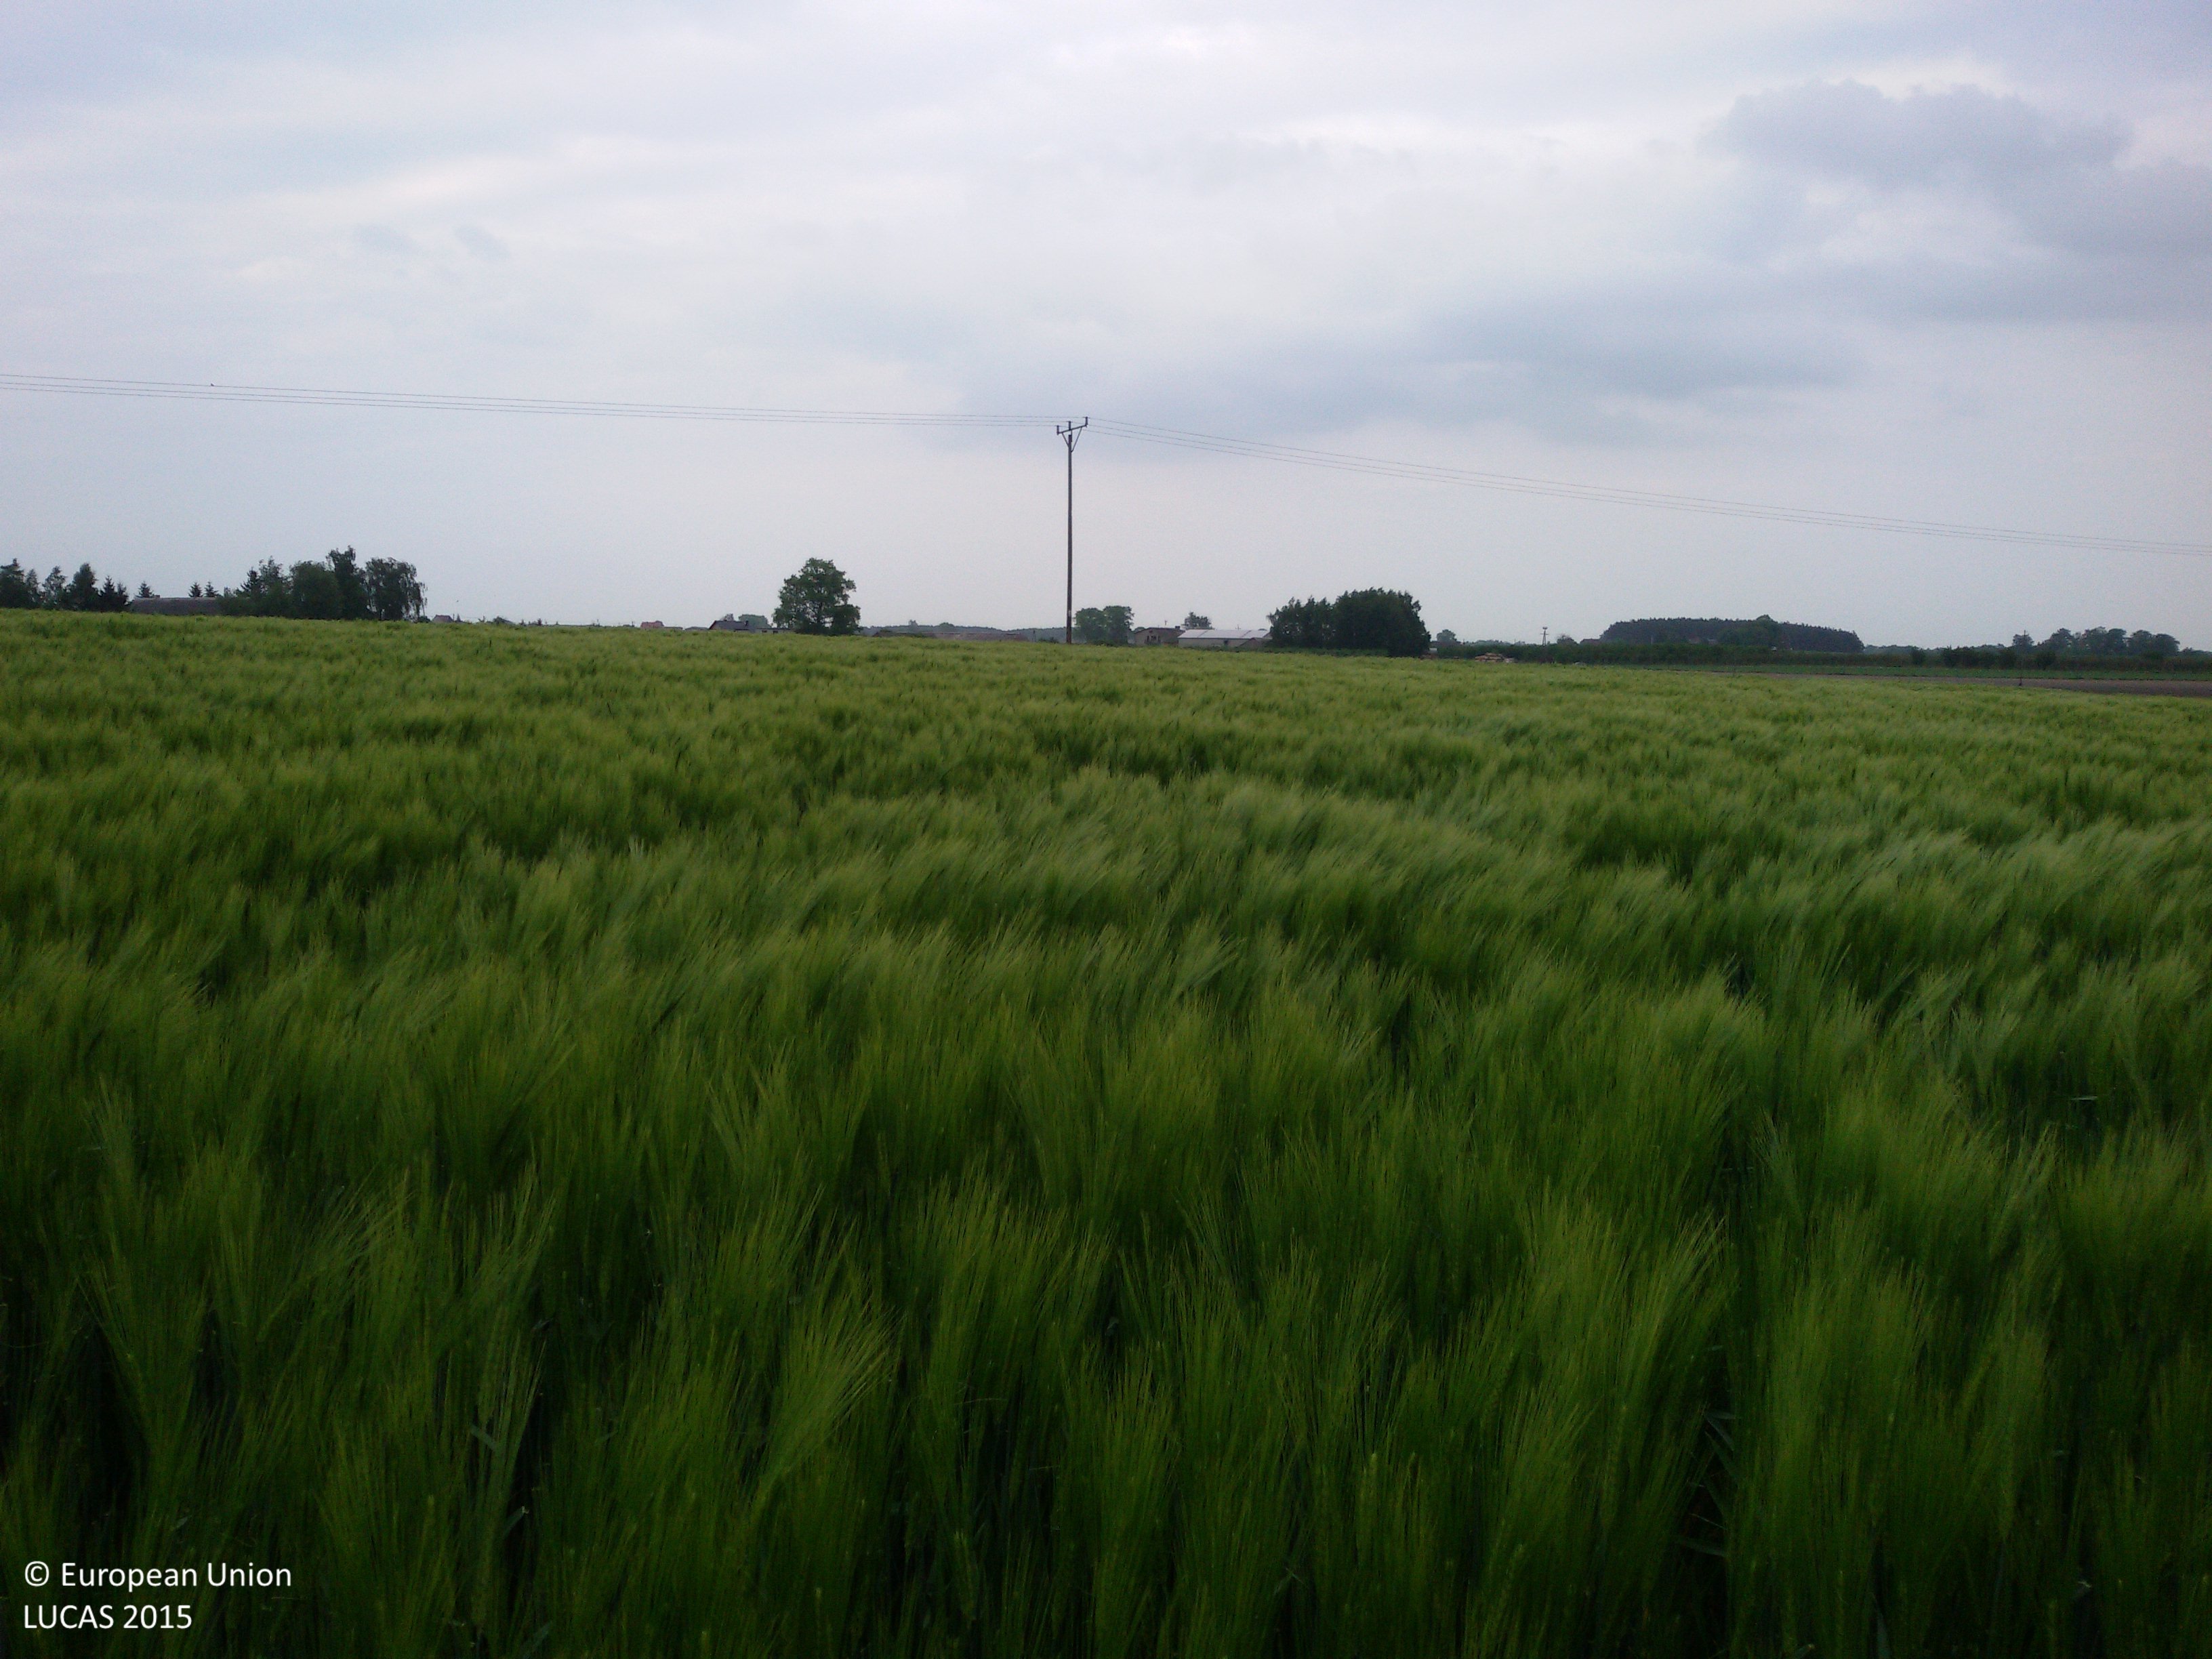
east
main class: Cropland
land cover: Barley
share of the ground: > 75 %
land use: Agriculture (excluding fallow land and kitchen gardens)
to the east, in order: Barley; Tracks; Maize; Electric lines; Maize
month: May
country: PL
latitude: 53.1853
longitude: 17.2385
